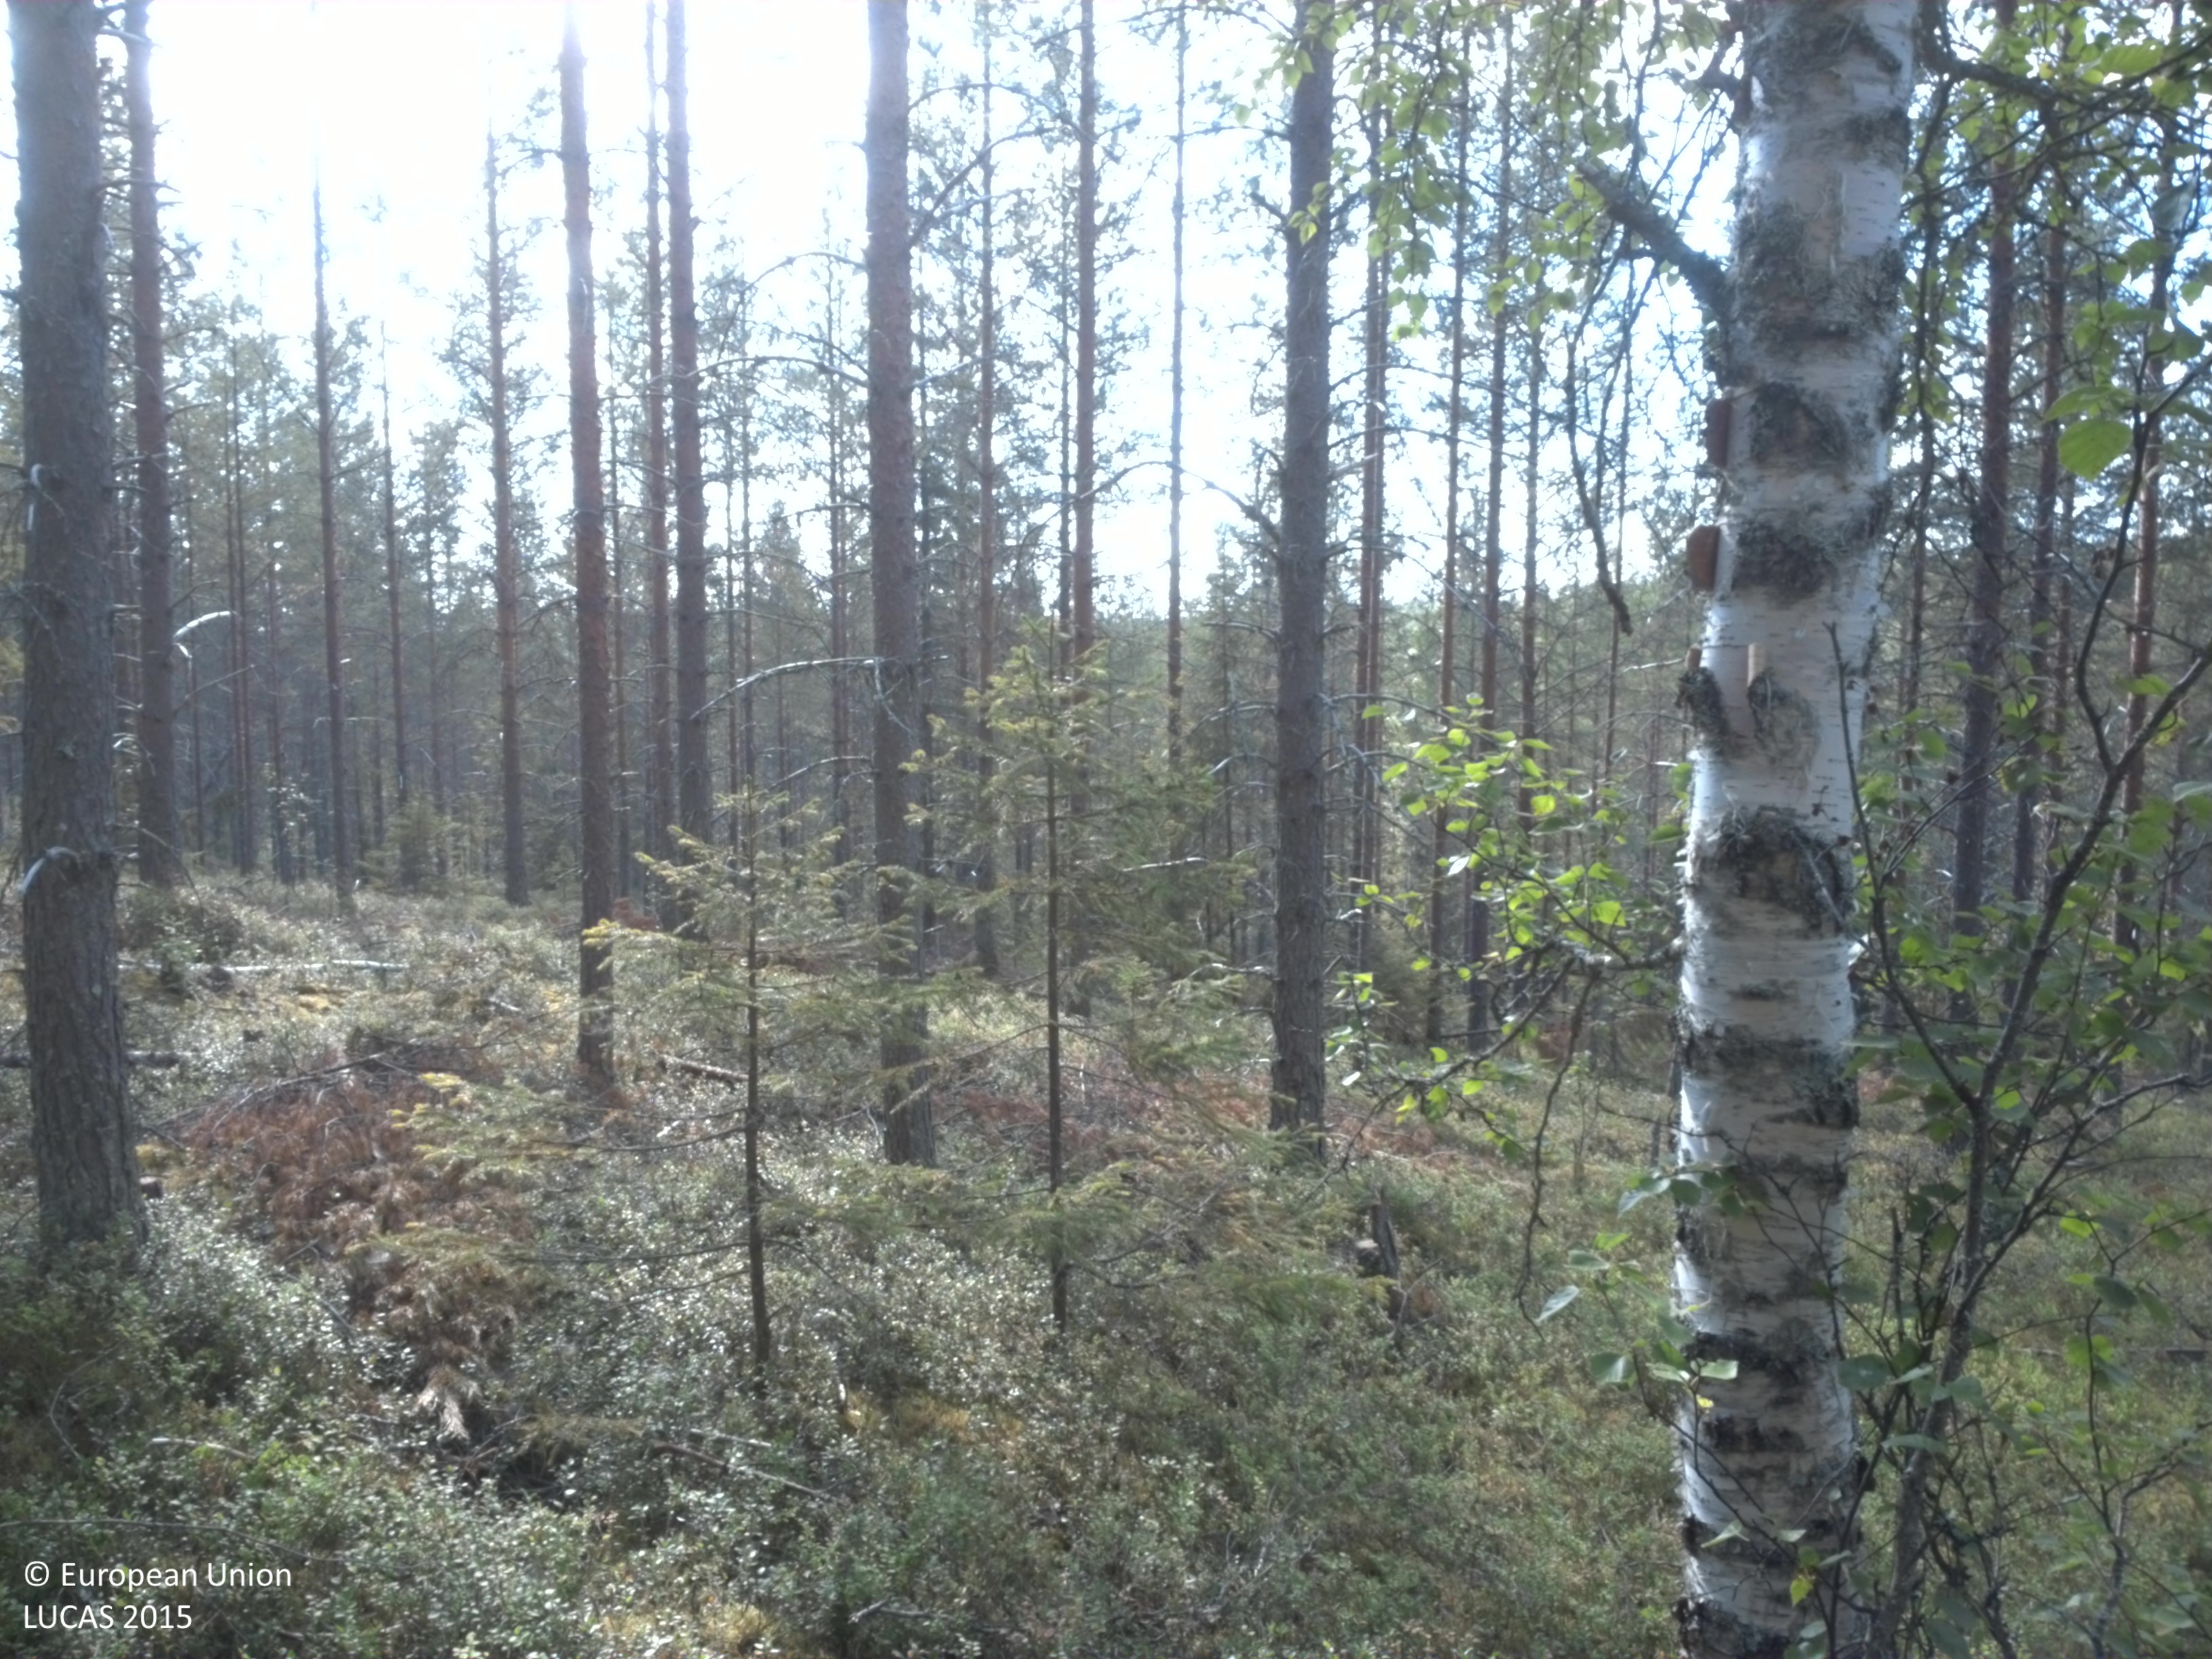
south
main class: Woodland
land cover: Pine dominated coniferous woodland
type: boreal forest
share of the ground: 50 - 75 %
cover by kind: coniferous forest trees 55 %, shrubs 40 %, lichens and mosses 5 %
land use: Forestry
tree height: > 5 m
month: August
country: SE
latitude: 64.5964
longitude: 19.0152
